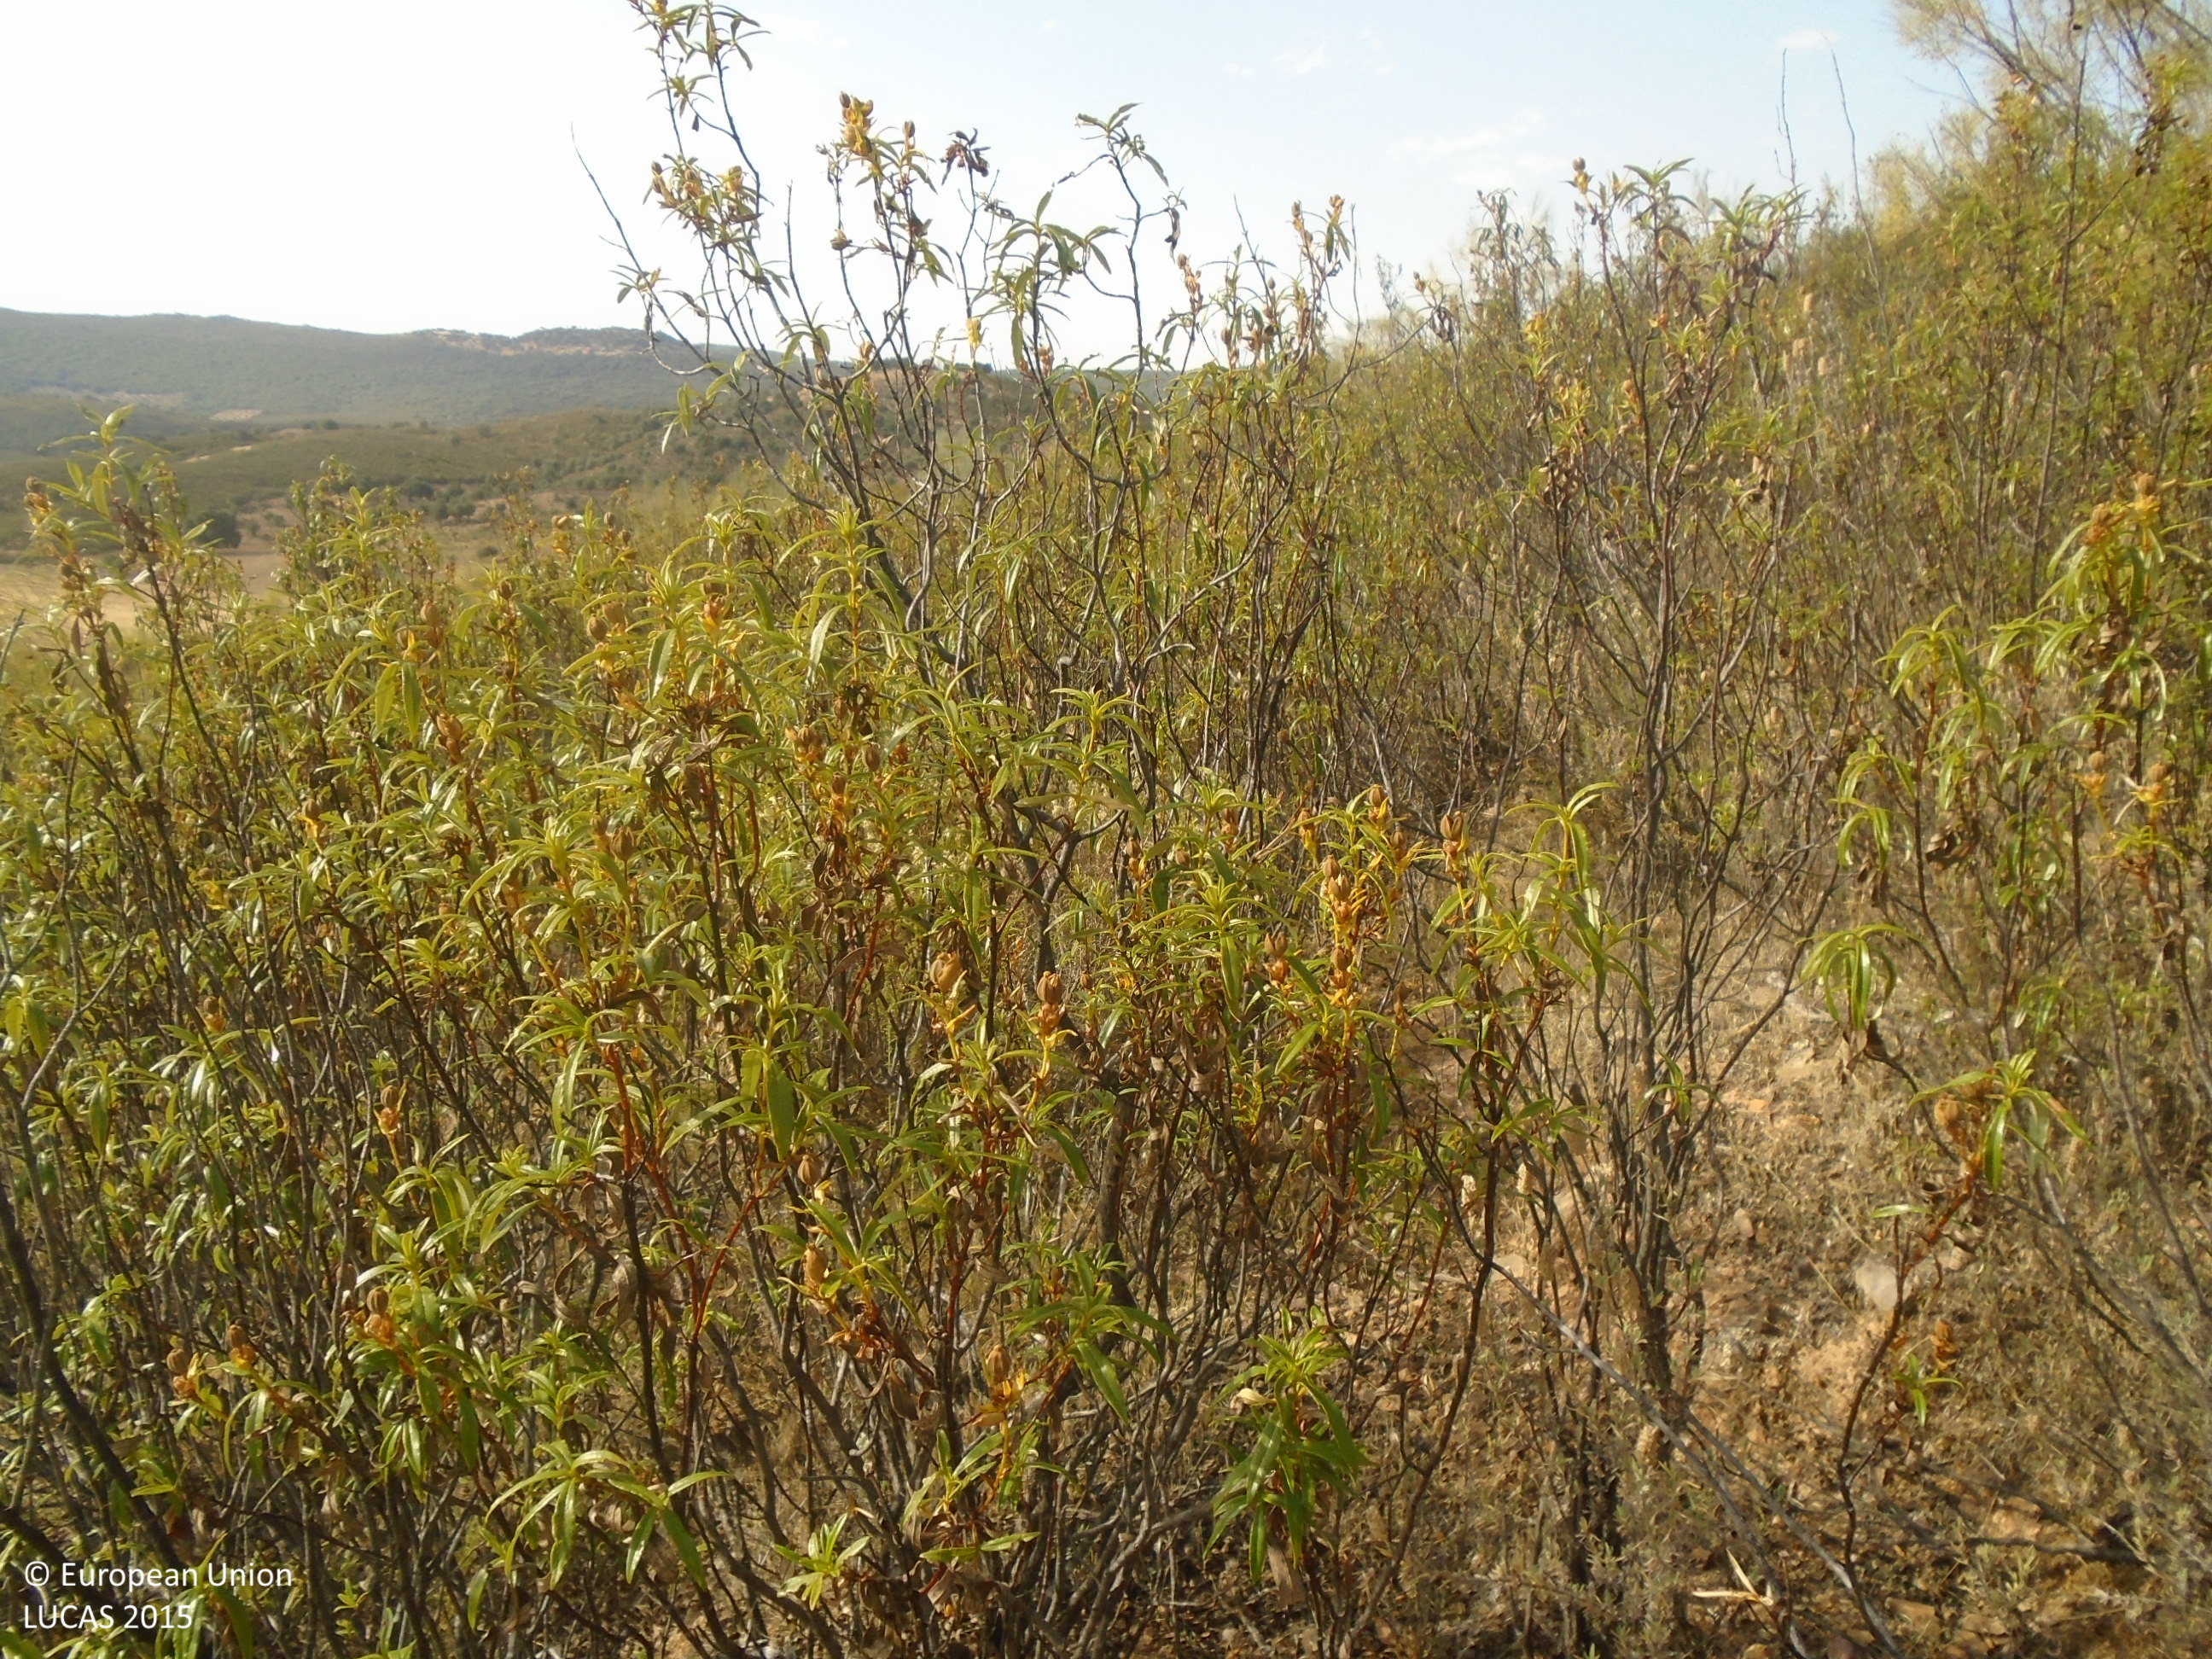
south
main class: Shrubland
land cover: Shrubland without tree cover
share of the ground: > 75 %
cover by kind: shrubs 90 %, herbaceous plants 10 %
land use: Semi-natural and natural areas not in use
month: July
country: ES
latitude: 39.2030
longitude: -4.4945
